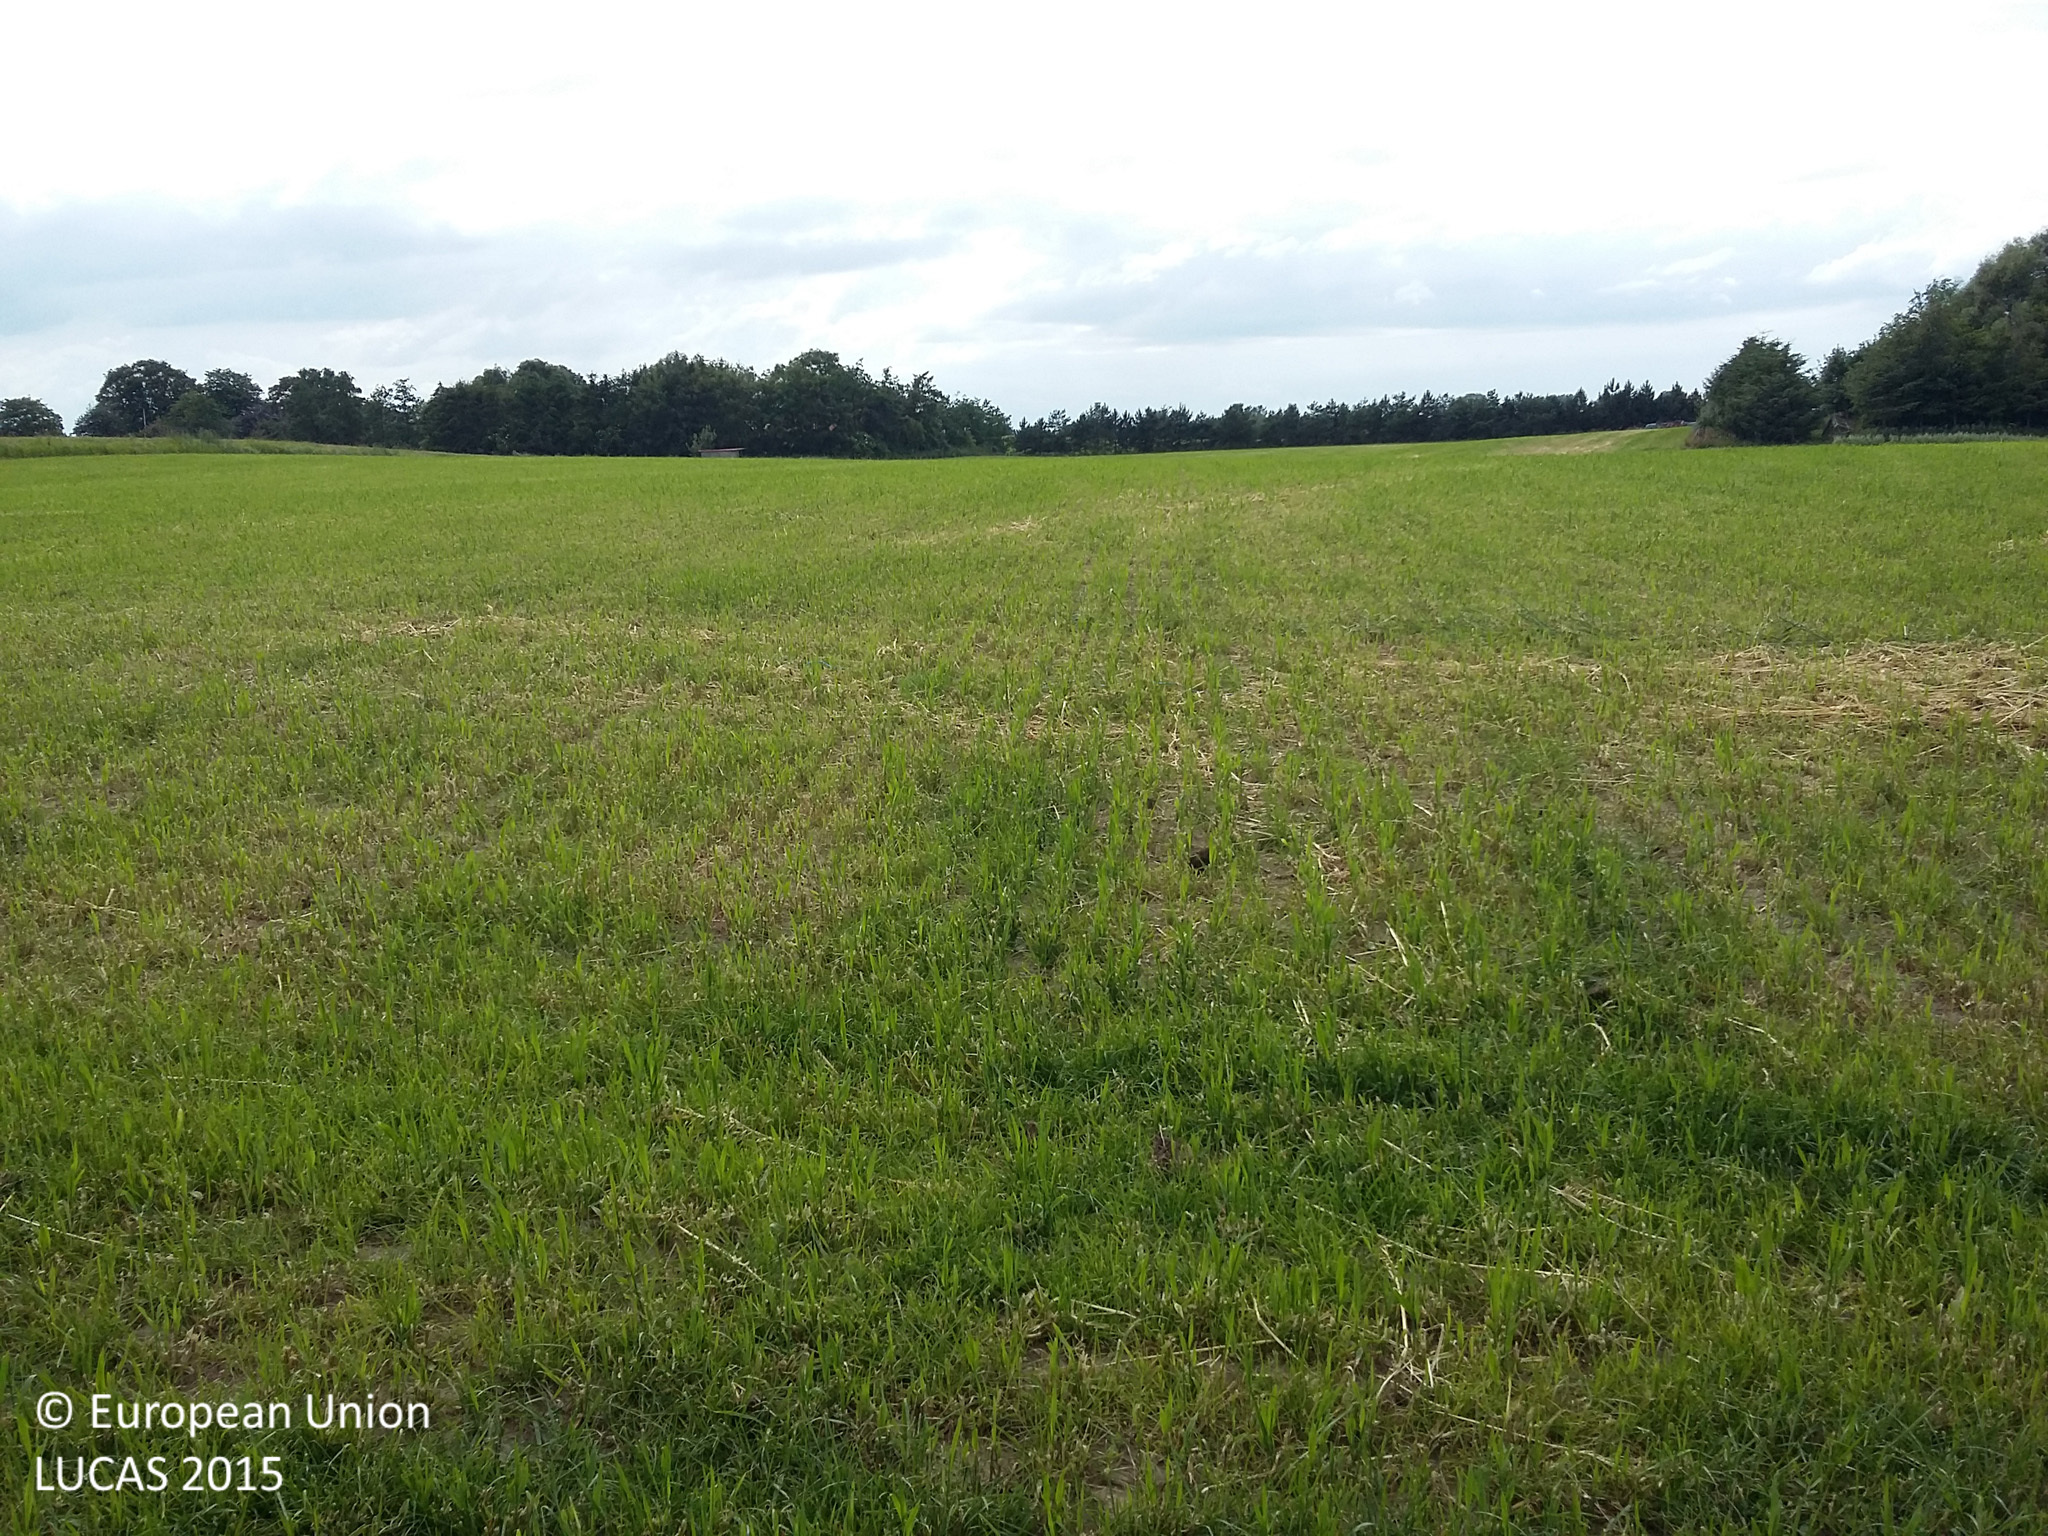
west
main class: Cropland
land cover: Oats
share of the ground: > 75 %
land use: Agriculture (excluding fallow land and kitchen gardens)
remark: Harvested field
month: July
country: DK
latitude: 55.4972
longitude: 11.3759
